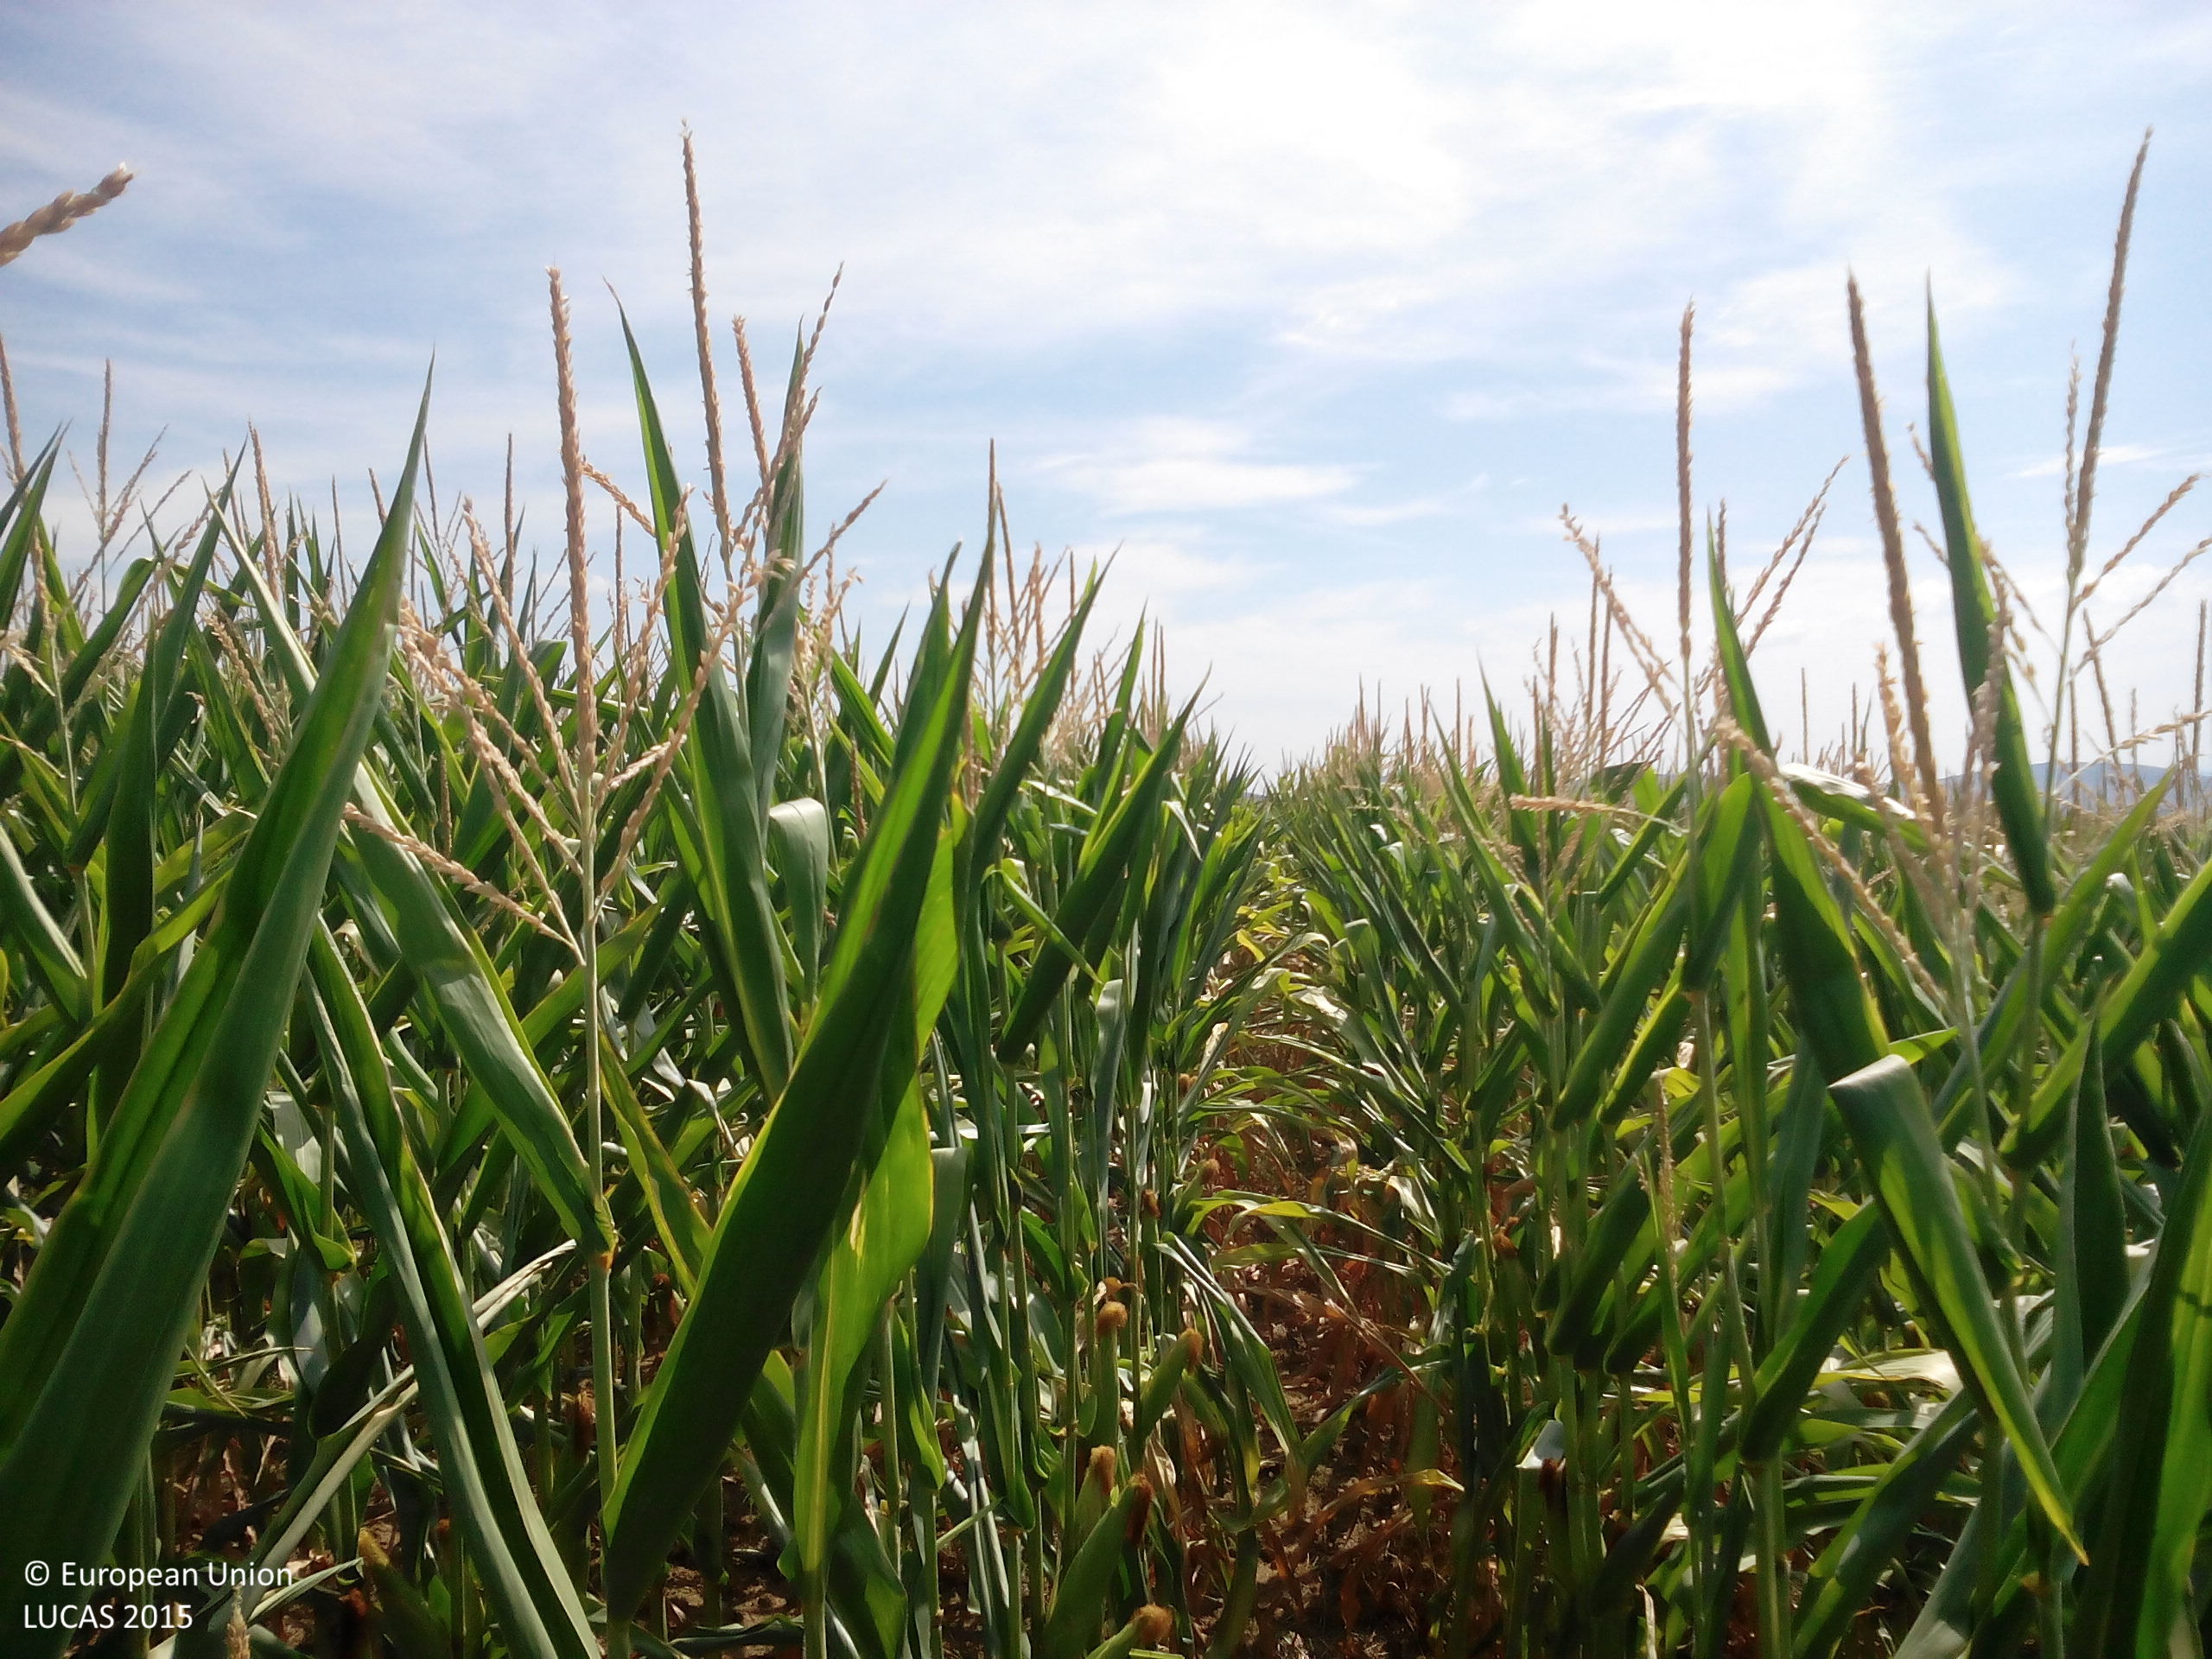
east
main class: Cropland
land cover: Maize
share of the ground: > 75 %
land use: Agriculture (excluding fallow land and kitchen gardens)
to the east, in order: Maize; Shrubland without tree cover; Tracks; Shruby margins; Sunflower
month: August
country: BG
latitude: 43.1871
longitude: 23.7900
